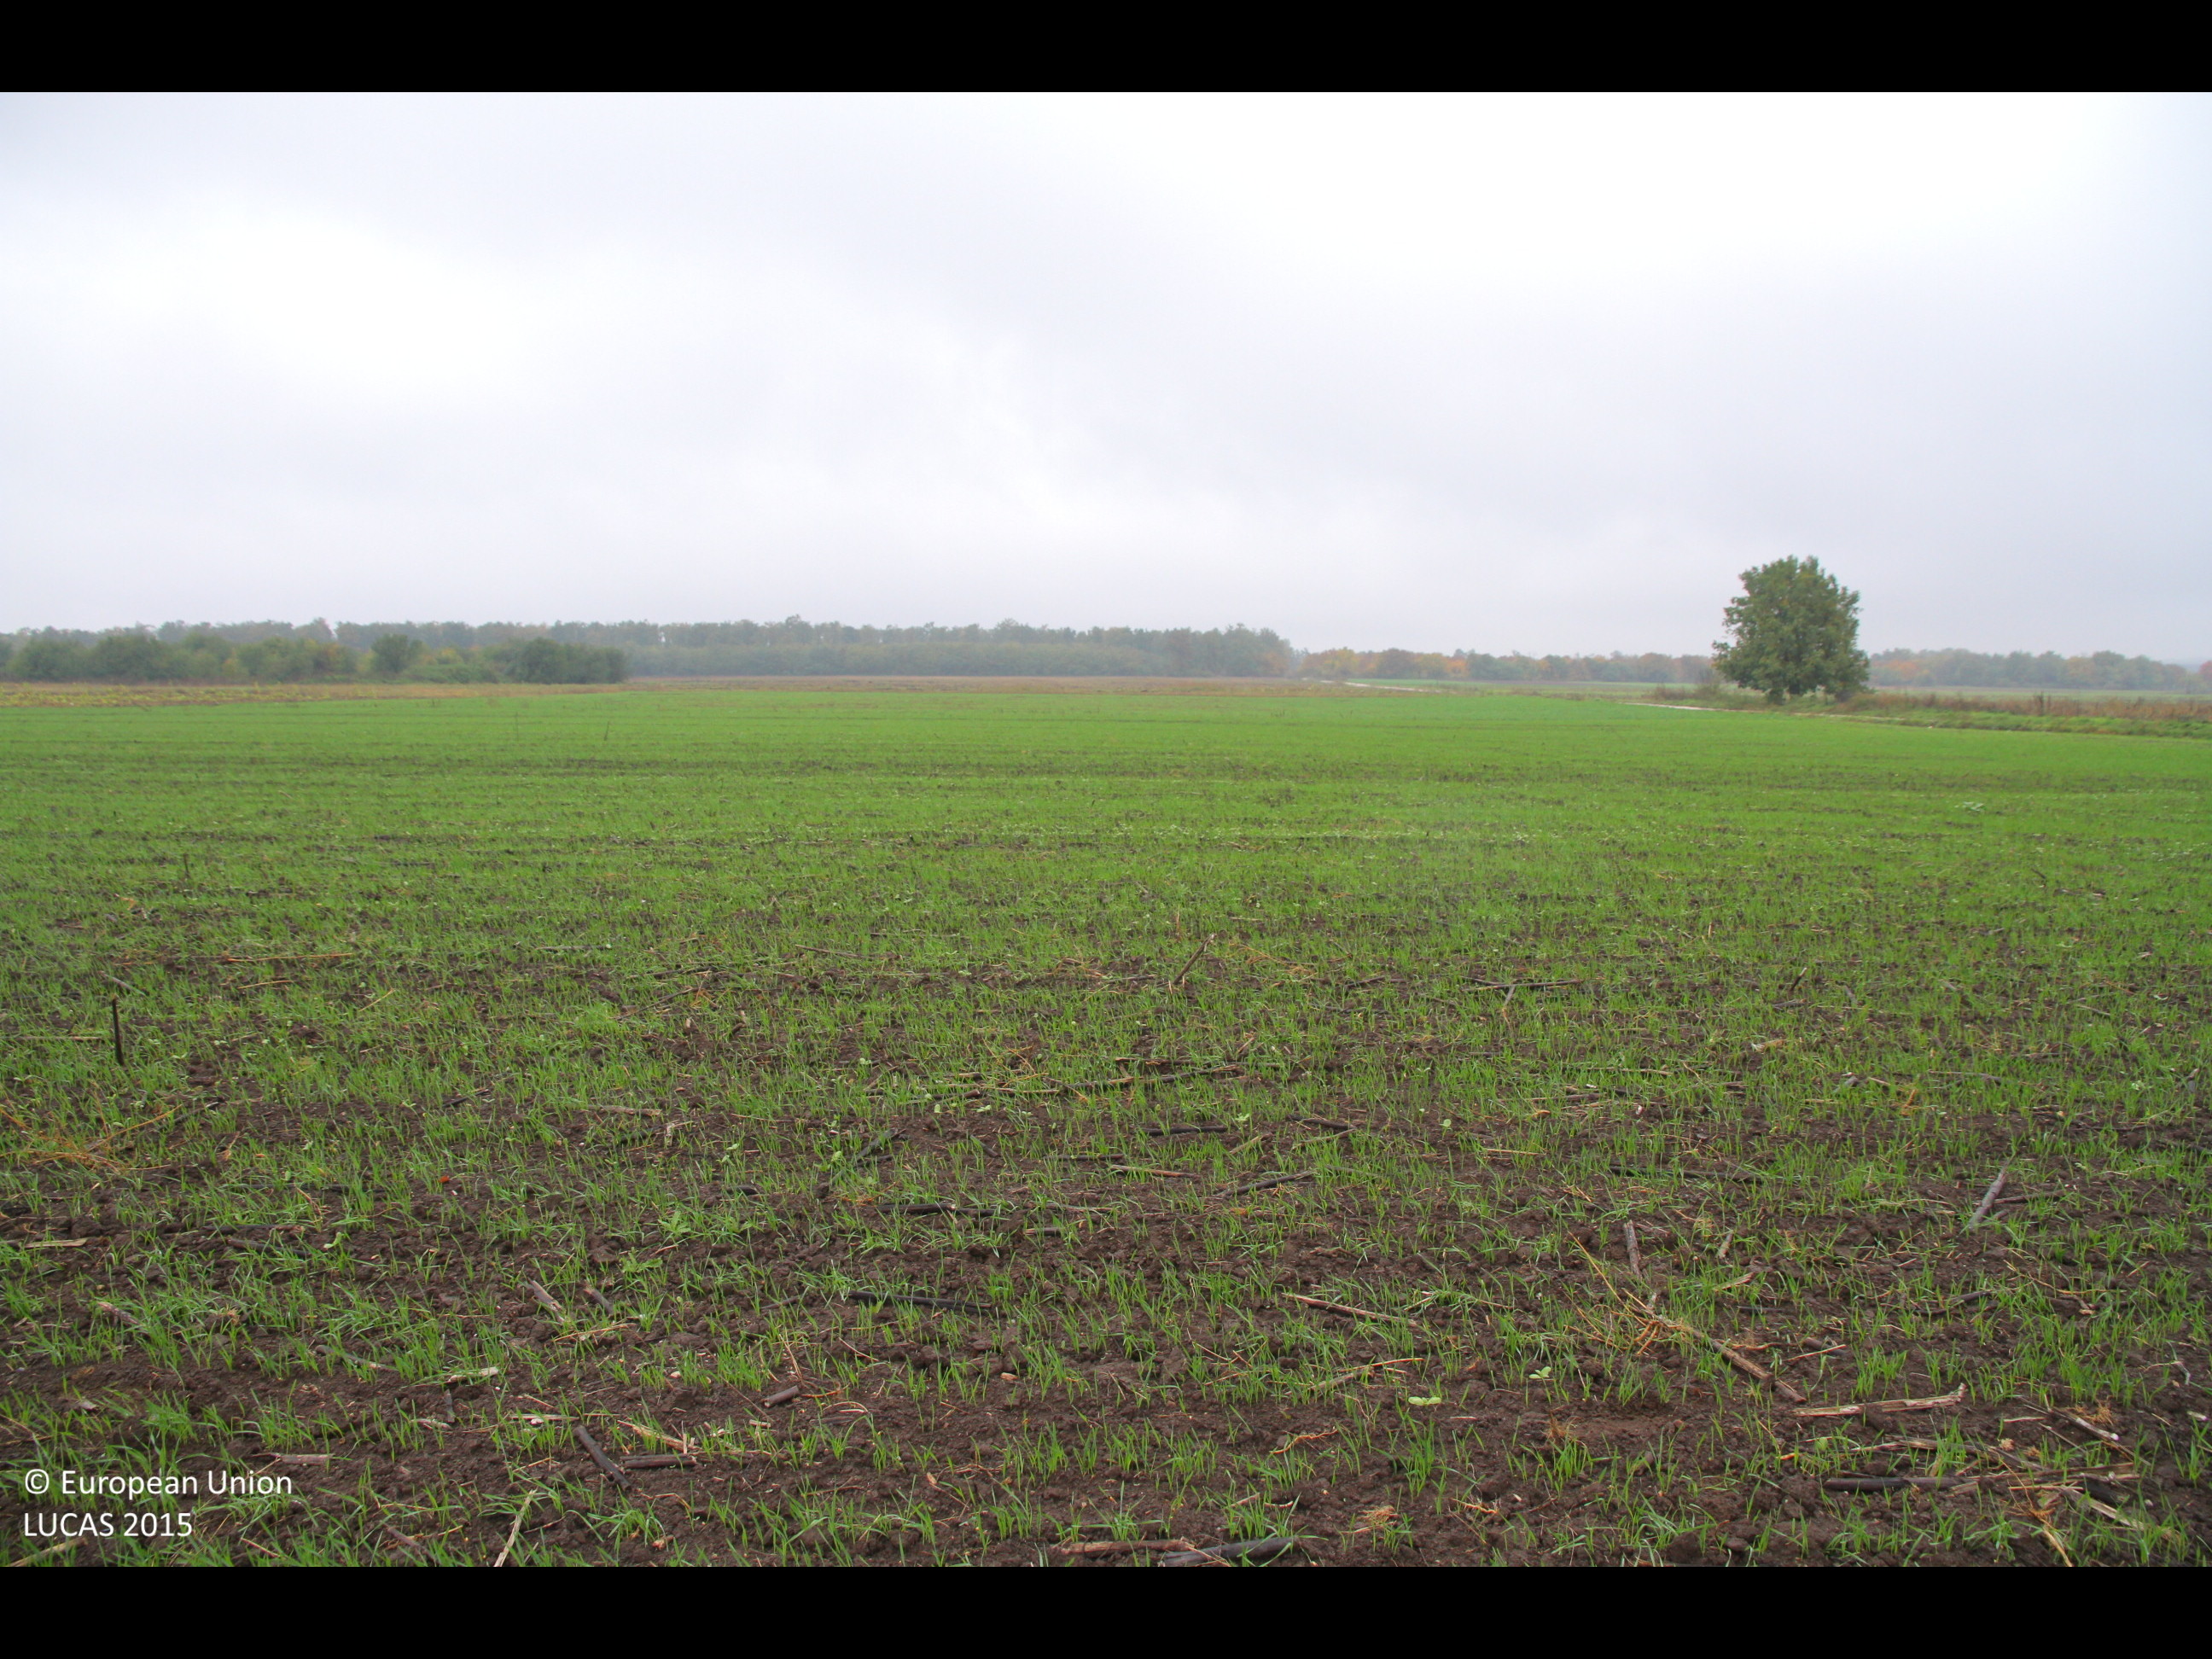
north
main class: Cropland
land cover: Common wheat
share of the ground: 25 - 50 %
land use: Agriculture (excluding fallow land and kitchen gardens)
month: October
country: BG
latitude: 43.6714
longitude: 26.9994
